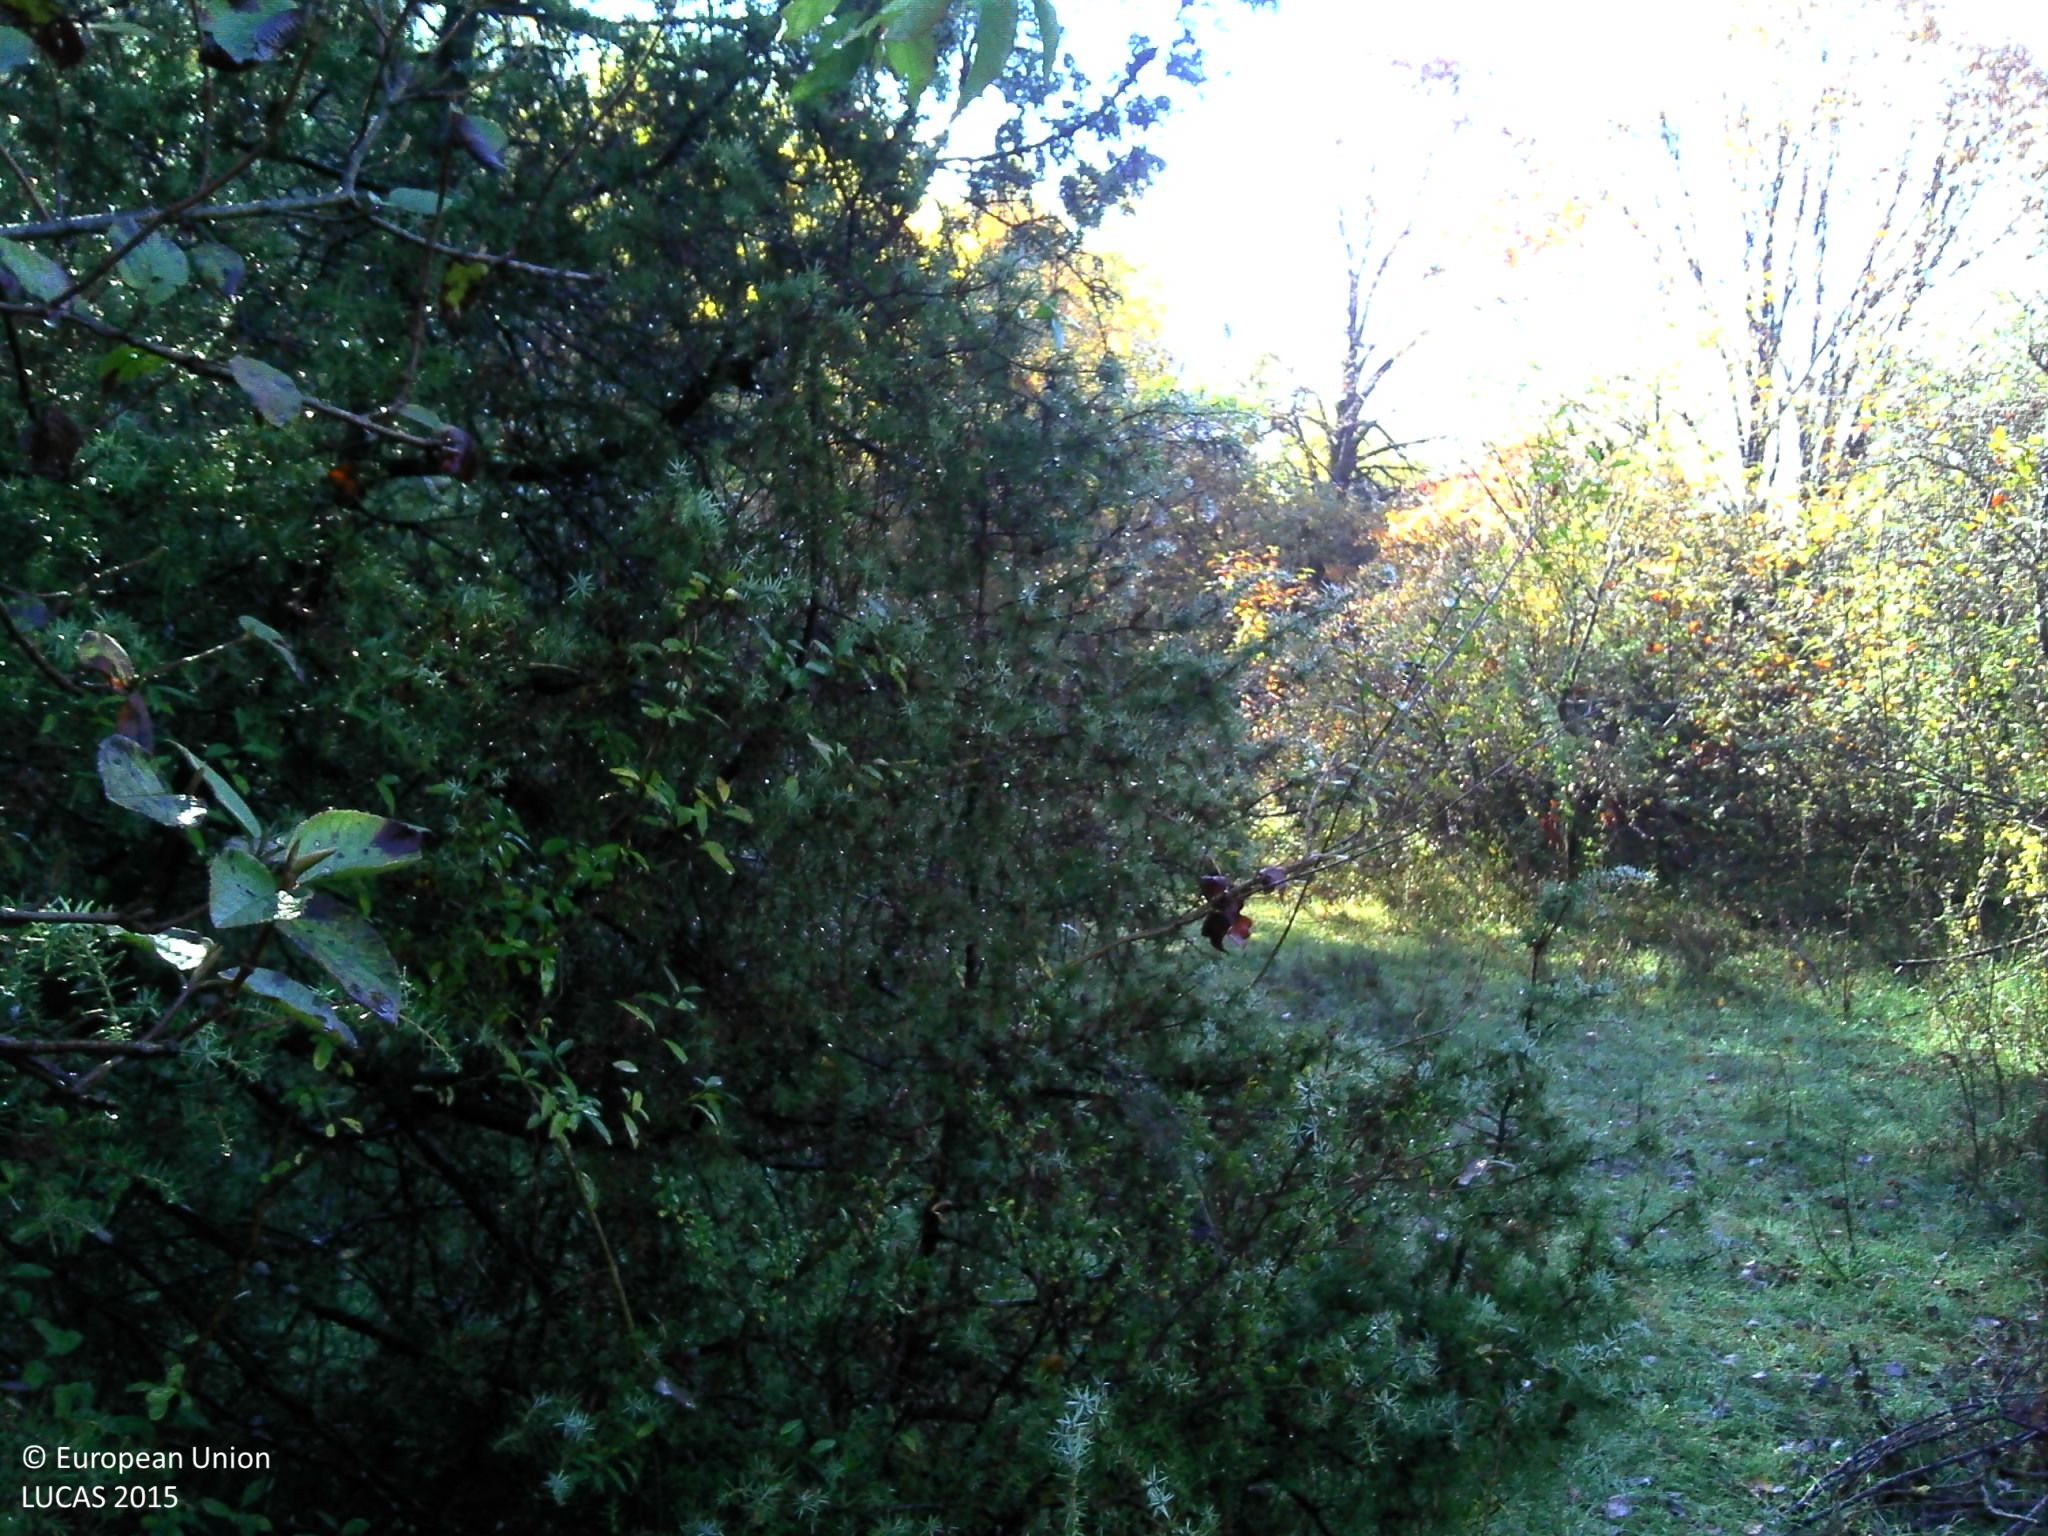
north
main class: Shrubland
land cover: Shrubland with sparse tree cover
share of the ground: > 75 %
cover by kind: shrubs 80 %, herbaceous plants 10 %, broadleaved forest trees 5 %, lichens and mosses 5 %
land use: Agriculture (excluding fallow land and kitchen gardens)
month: October
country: FR
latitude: 45.9949
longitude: 5.2909
